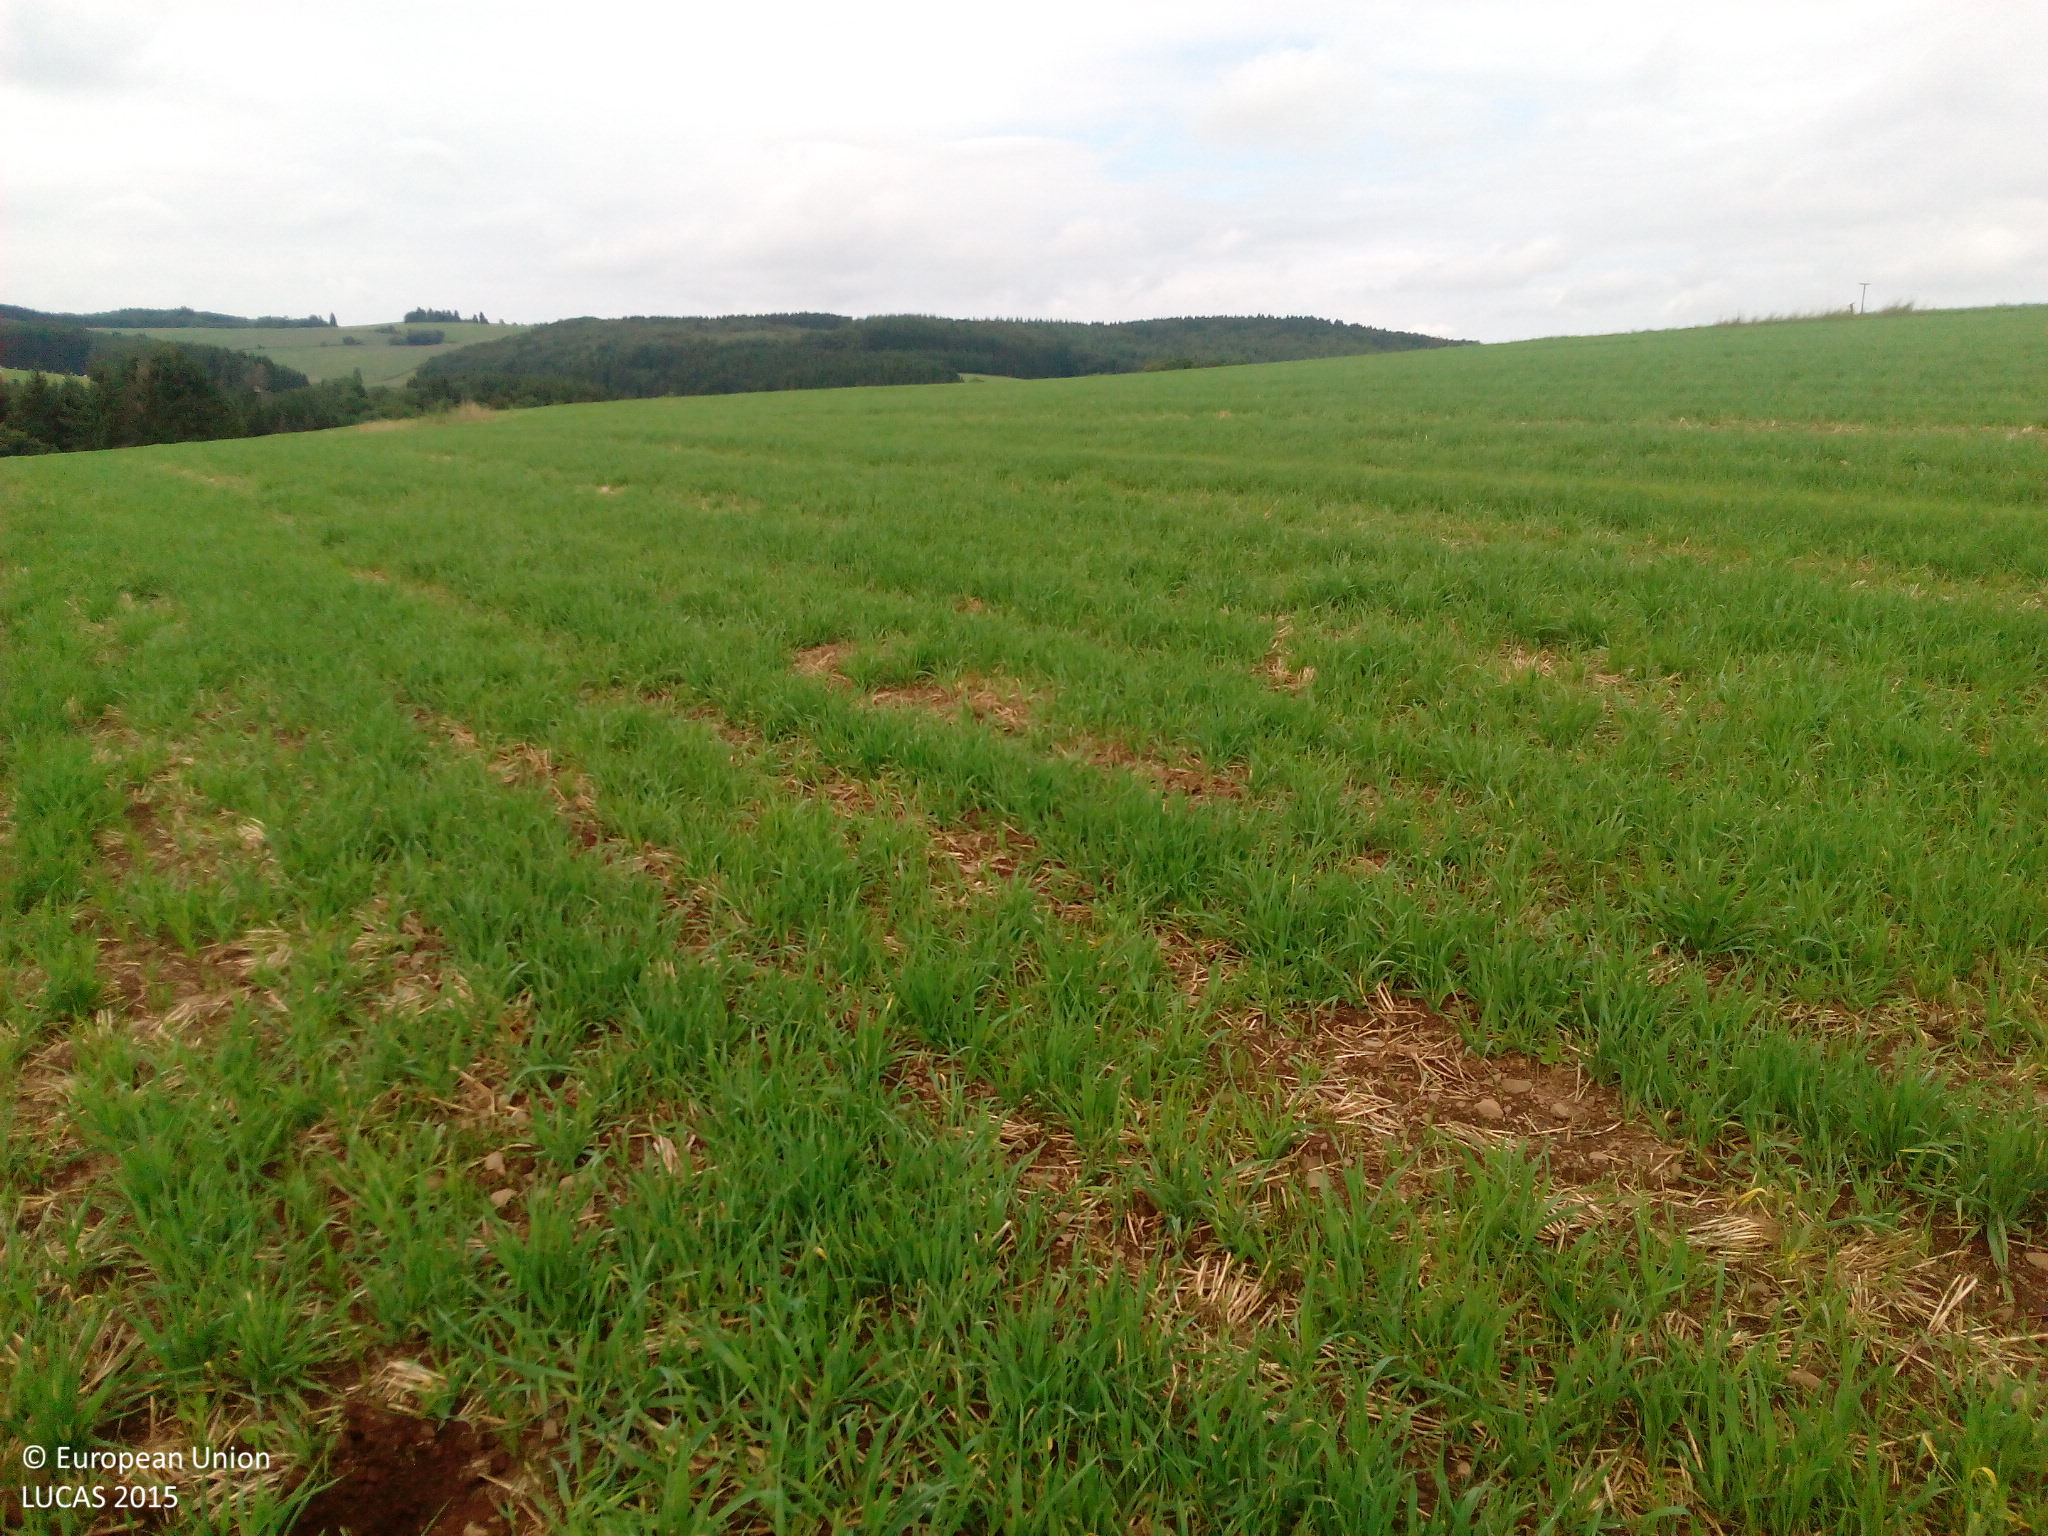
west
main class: Cropland
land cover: Barley
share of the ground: < 10 %
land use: Agriculture (excluding fallow land and kitchen gardens)
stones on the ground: < 10 %
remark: Harvested field
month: August
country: DE
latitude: 50.2138
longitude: 6.2858
